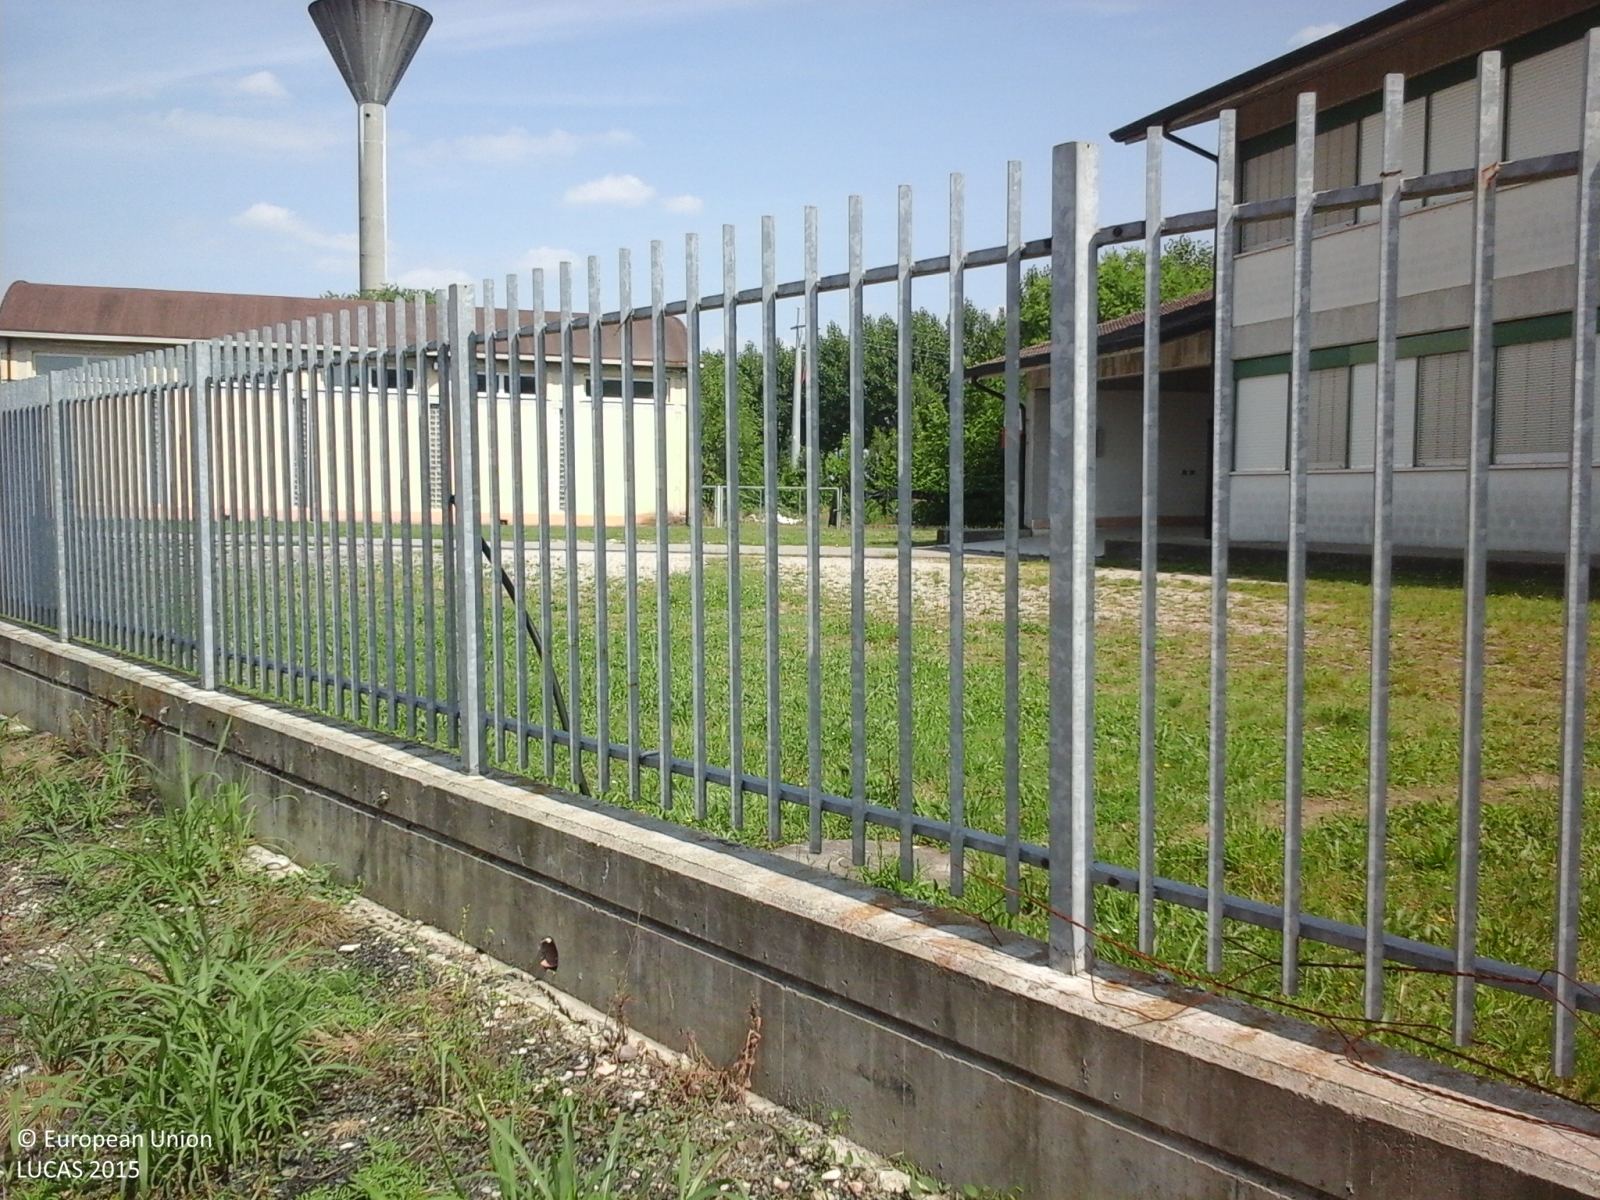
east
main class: Grassland
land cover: Grassland without tree/shrub cover
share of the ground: > 75 %
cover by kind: herbaceous plants 100 %
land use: Community services
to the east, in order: Grassland without tree/shrub cover; Artificial constructions in urban areas; Abandoned hedges; Ditches and canals; Grass margins; Fences; Broadleaved woodland; Artificial constructions in urban areas
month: May
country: IT
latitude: 45.2115
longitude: 10.9786
